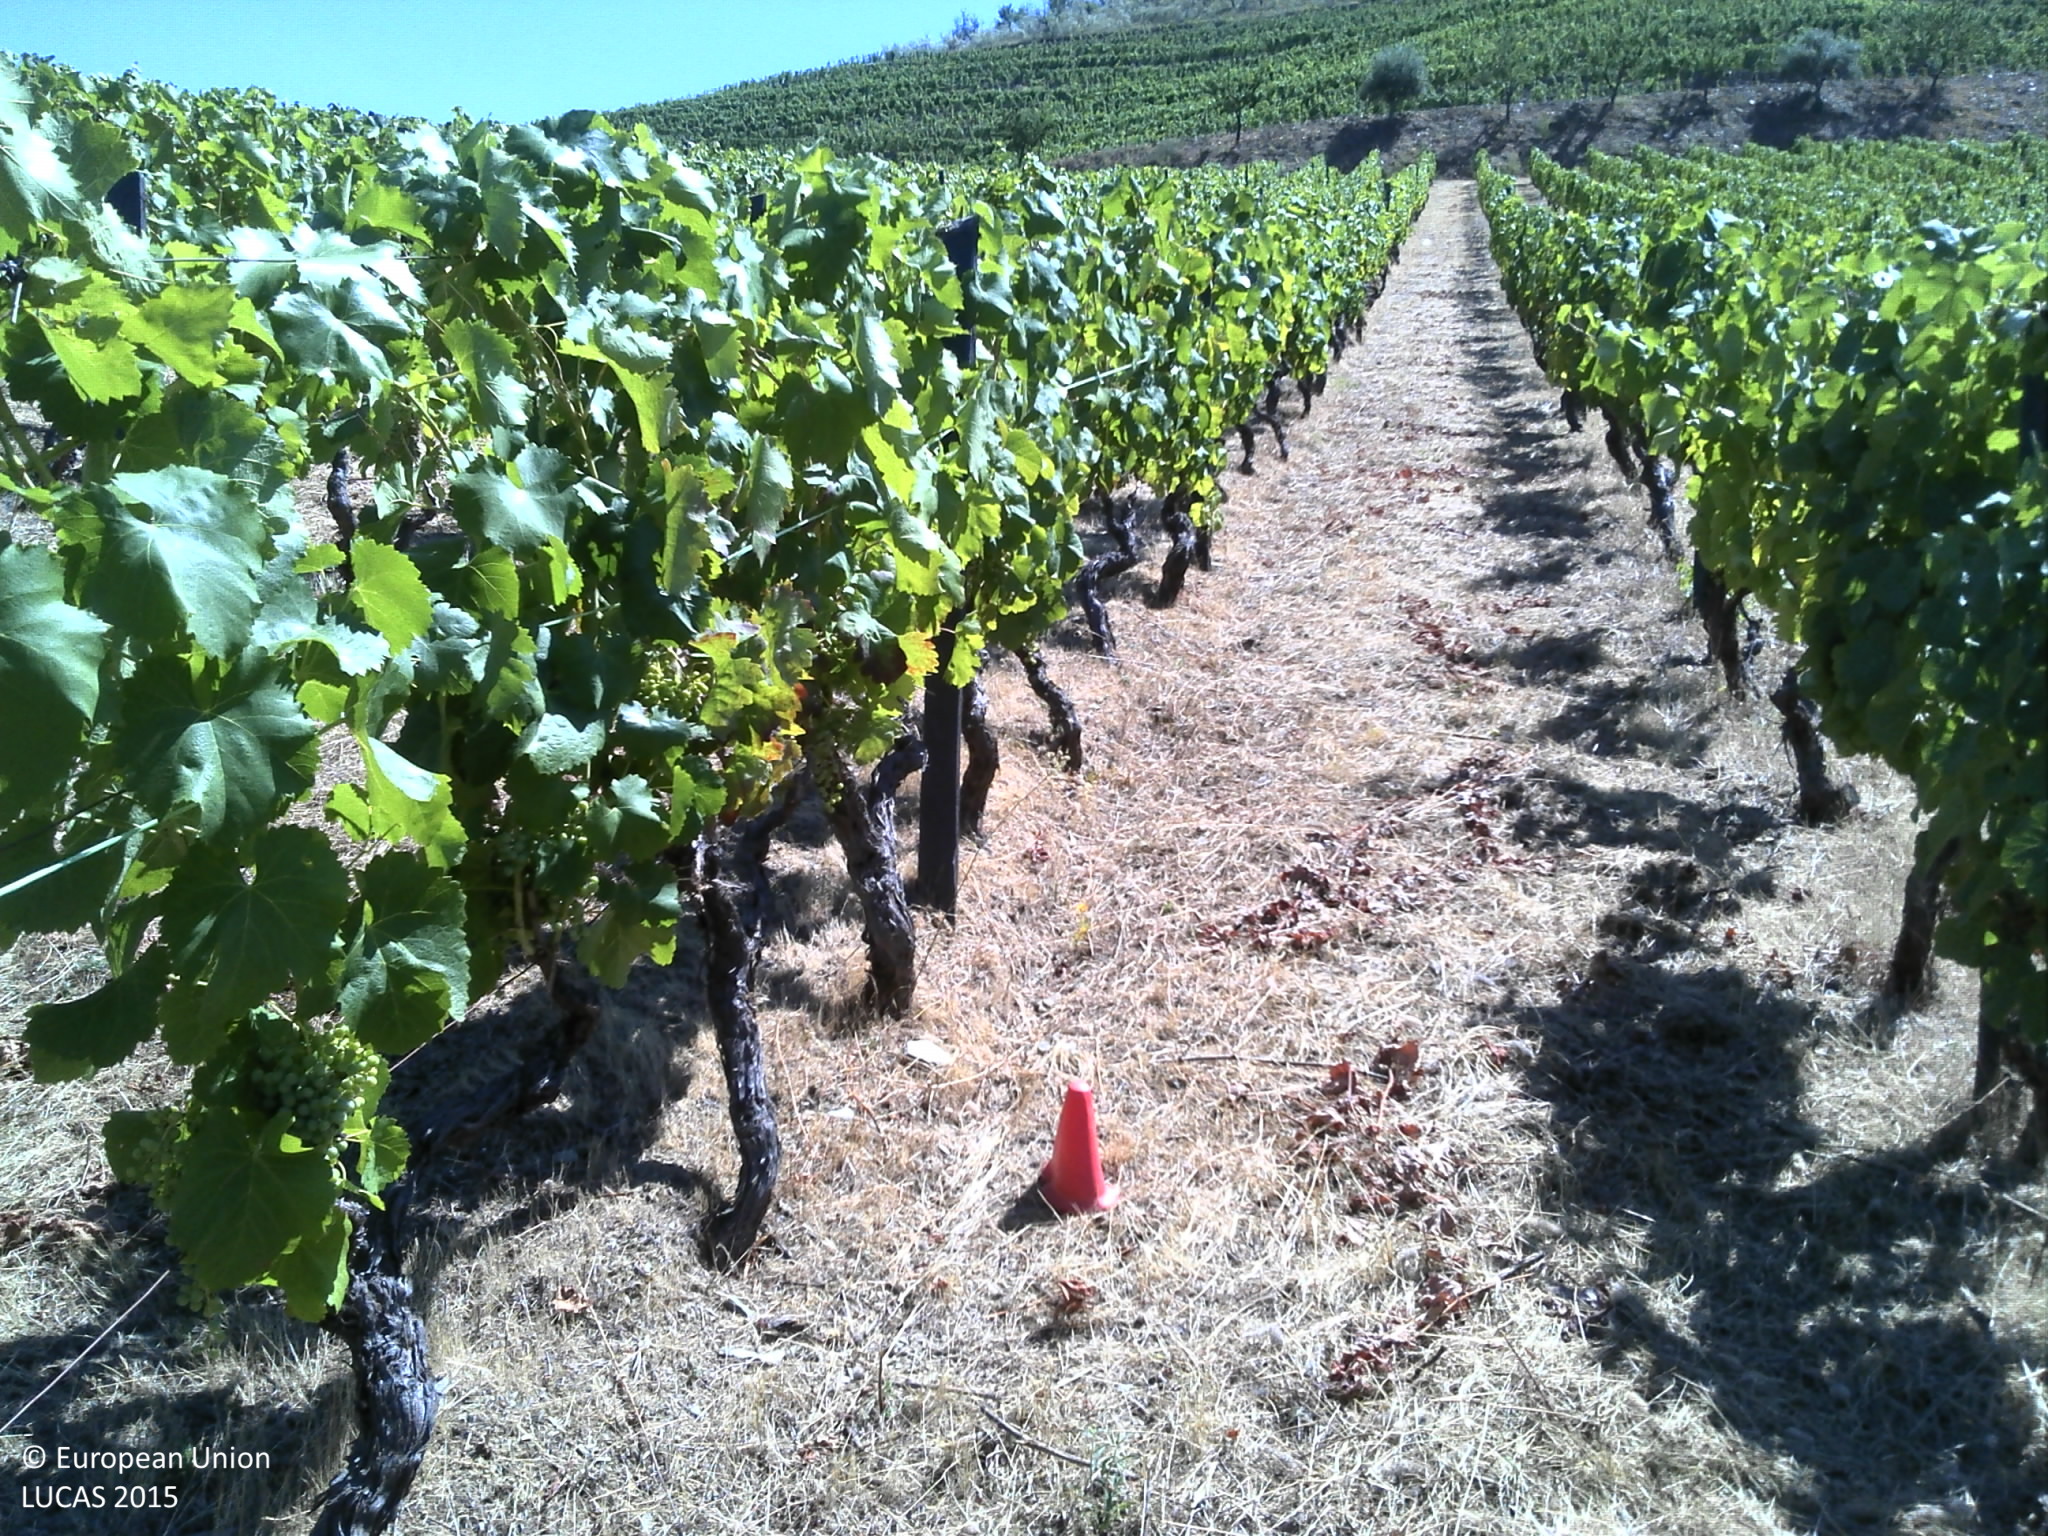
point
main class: Cropland
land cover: Vineyards
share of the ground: 10 - 25 %
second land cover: Grassland without tree/shrub cover
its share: > 75 %
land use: Agriculture (excluding fallow land and kitchen gardens)
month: June
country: PT
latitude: 41.0273
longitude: -6.9593
